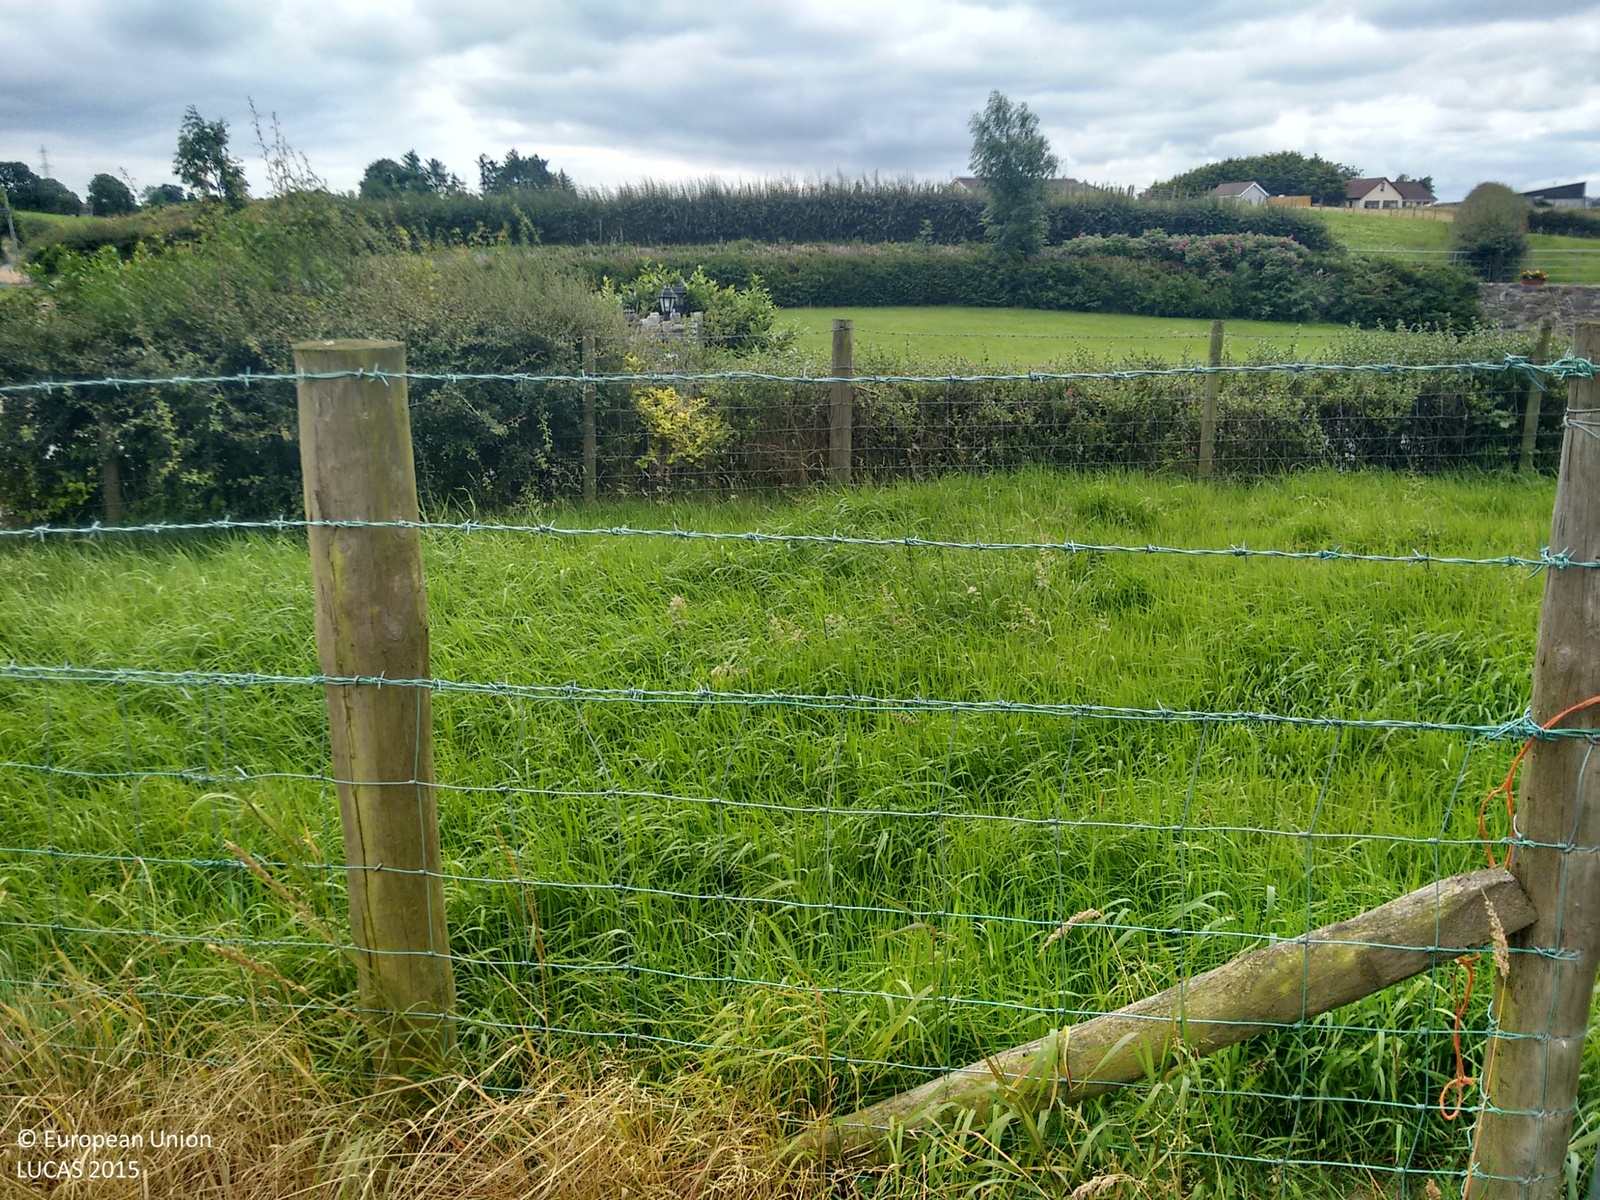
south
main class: Grassland
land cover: Grassland without tree/shrub cover
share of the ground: > 75 %
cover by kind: herbaceous plants 100 %
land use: Agriculture (excluding fallow land and kitchen gardens)
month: August
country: GB
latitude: 54.1579
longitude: -6.5901
